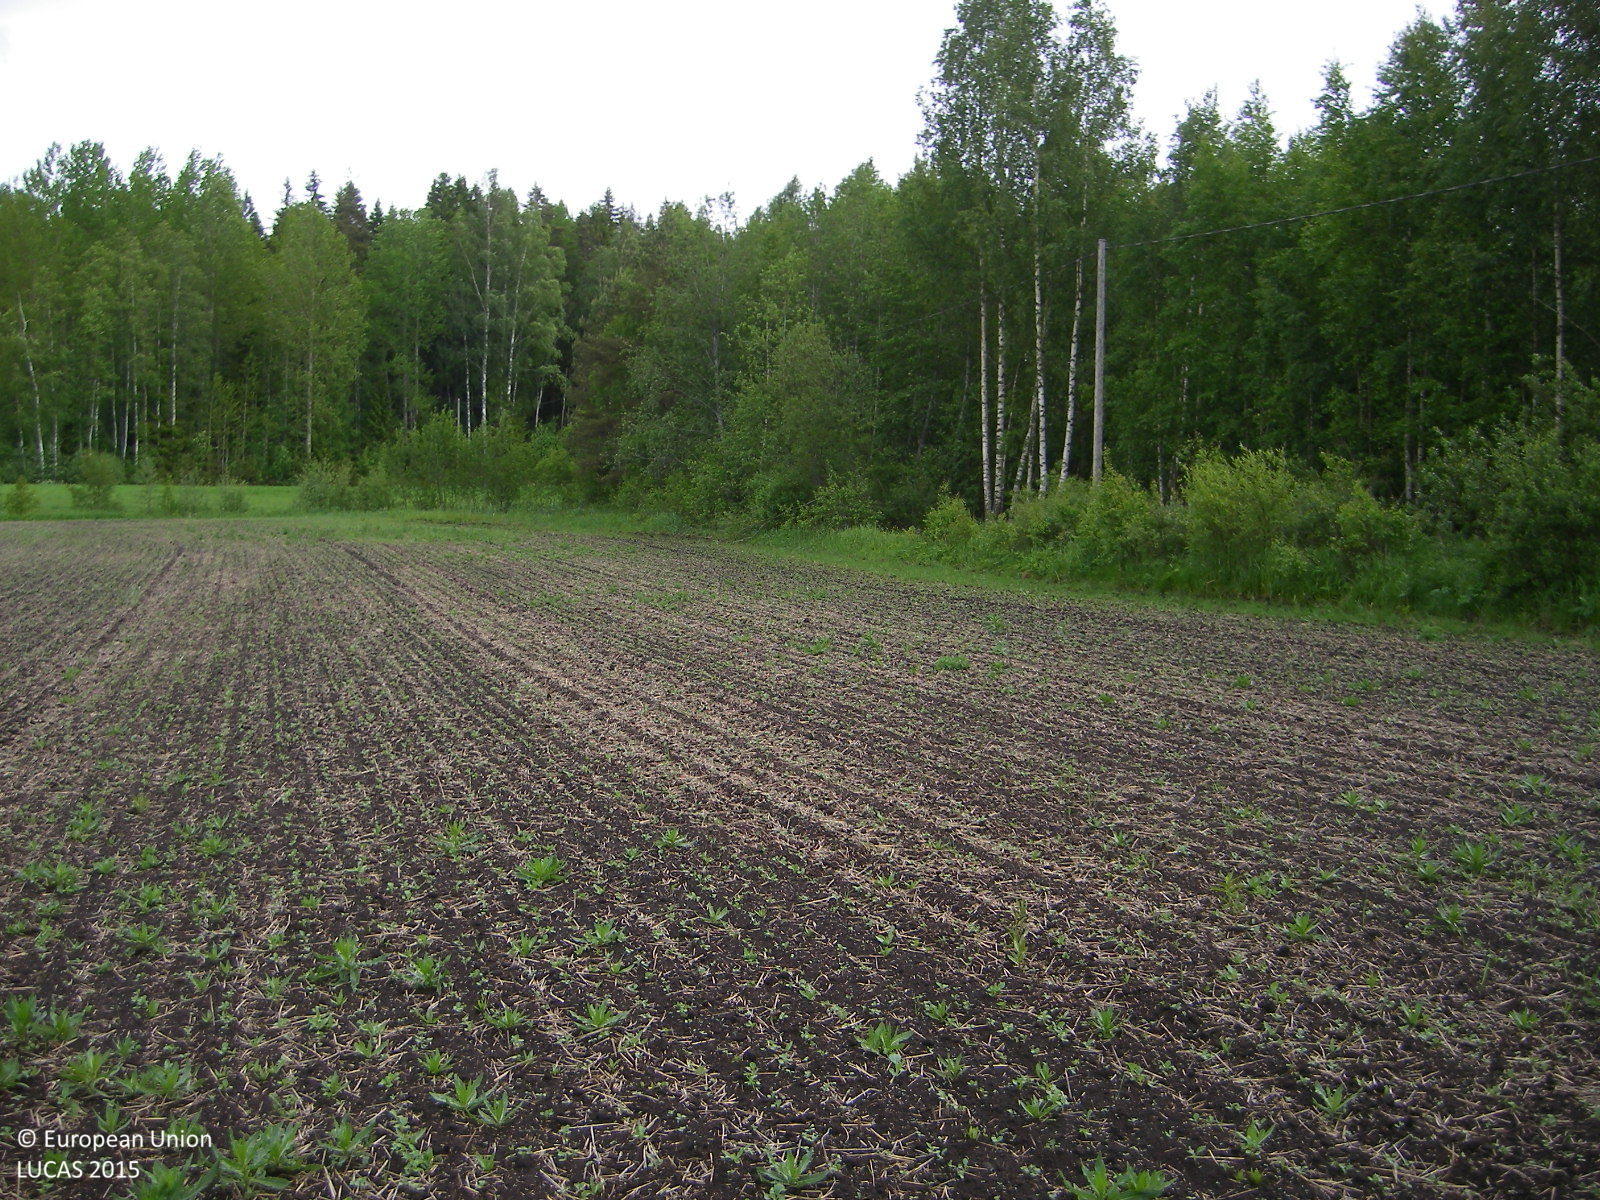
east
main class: Cropland
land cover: Other root crops
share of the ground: 10 - 25 %
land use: Agriculture (excluding fallow land and kitchen gardens)
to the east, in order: Other root crops; Grass margins; Abandoned hedges; Ditches and canals; Grass margins; Temporary grasslands; Broadleaved woodland; Grassland without tree/shrub cover; Spruce dominated mixed woodland
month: June
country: FI
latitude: 60.2621
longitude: 24.2174
